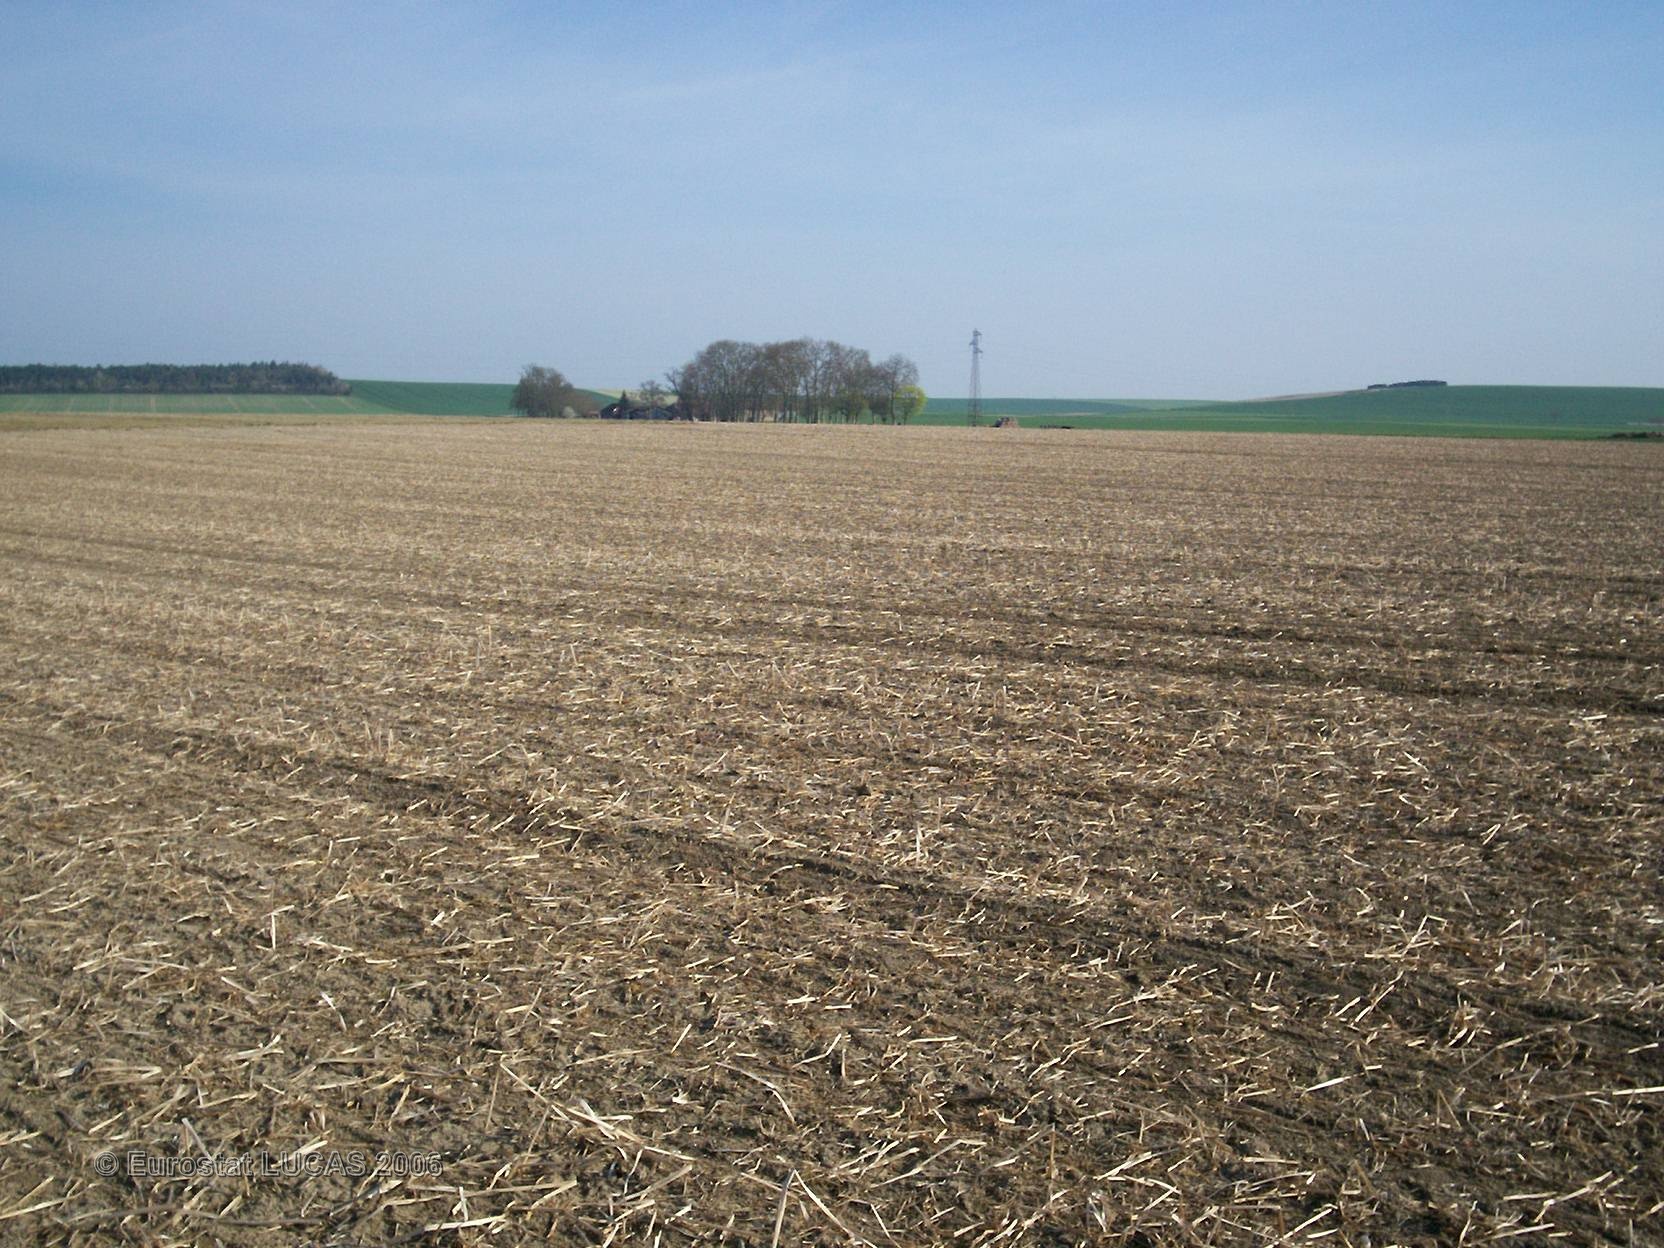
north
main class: Cropland
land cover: Sugar beet
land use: Agriculture (excluding fallow land and kitchen gardens)
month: April
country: FR
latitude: 48.4660
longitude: 4.5198
